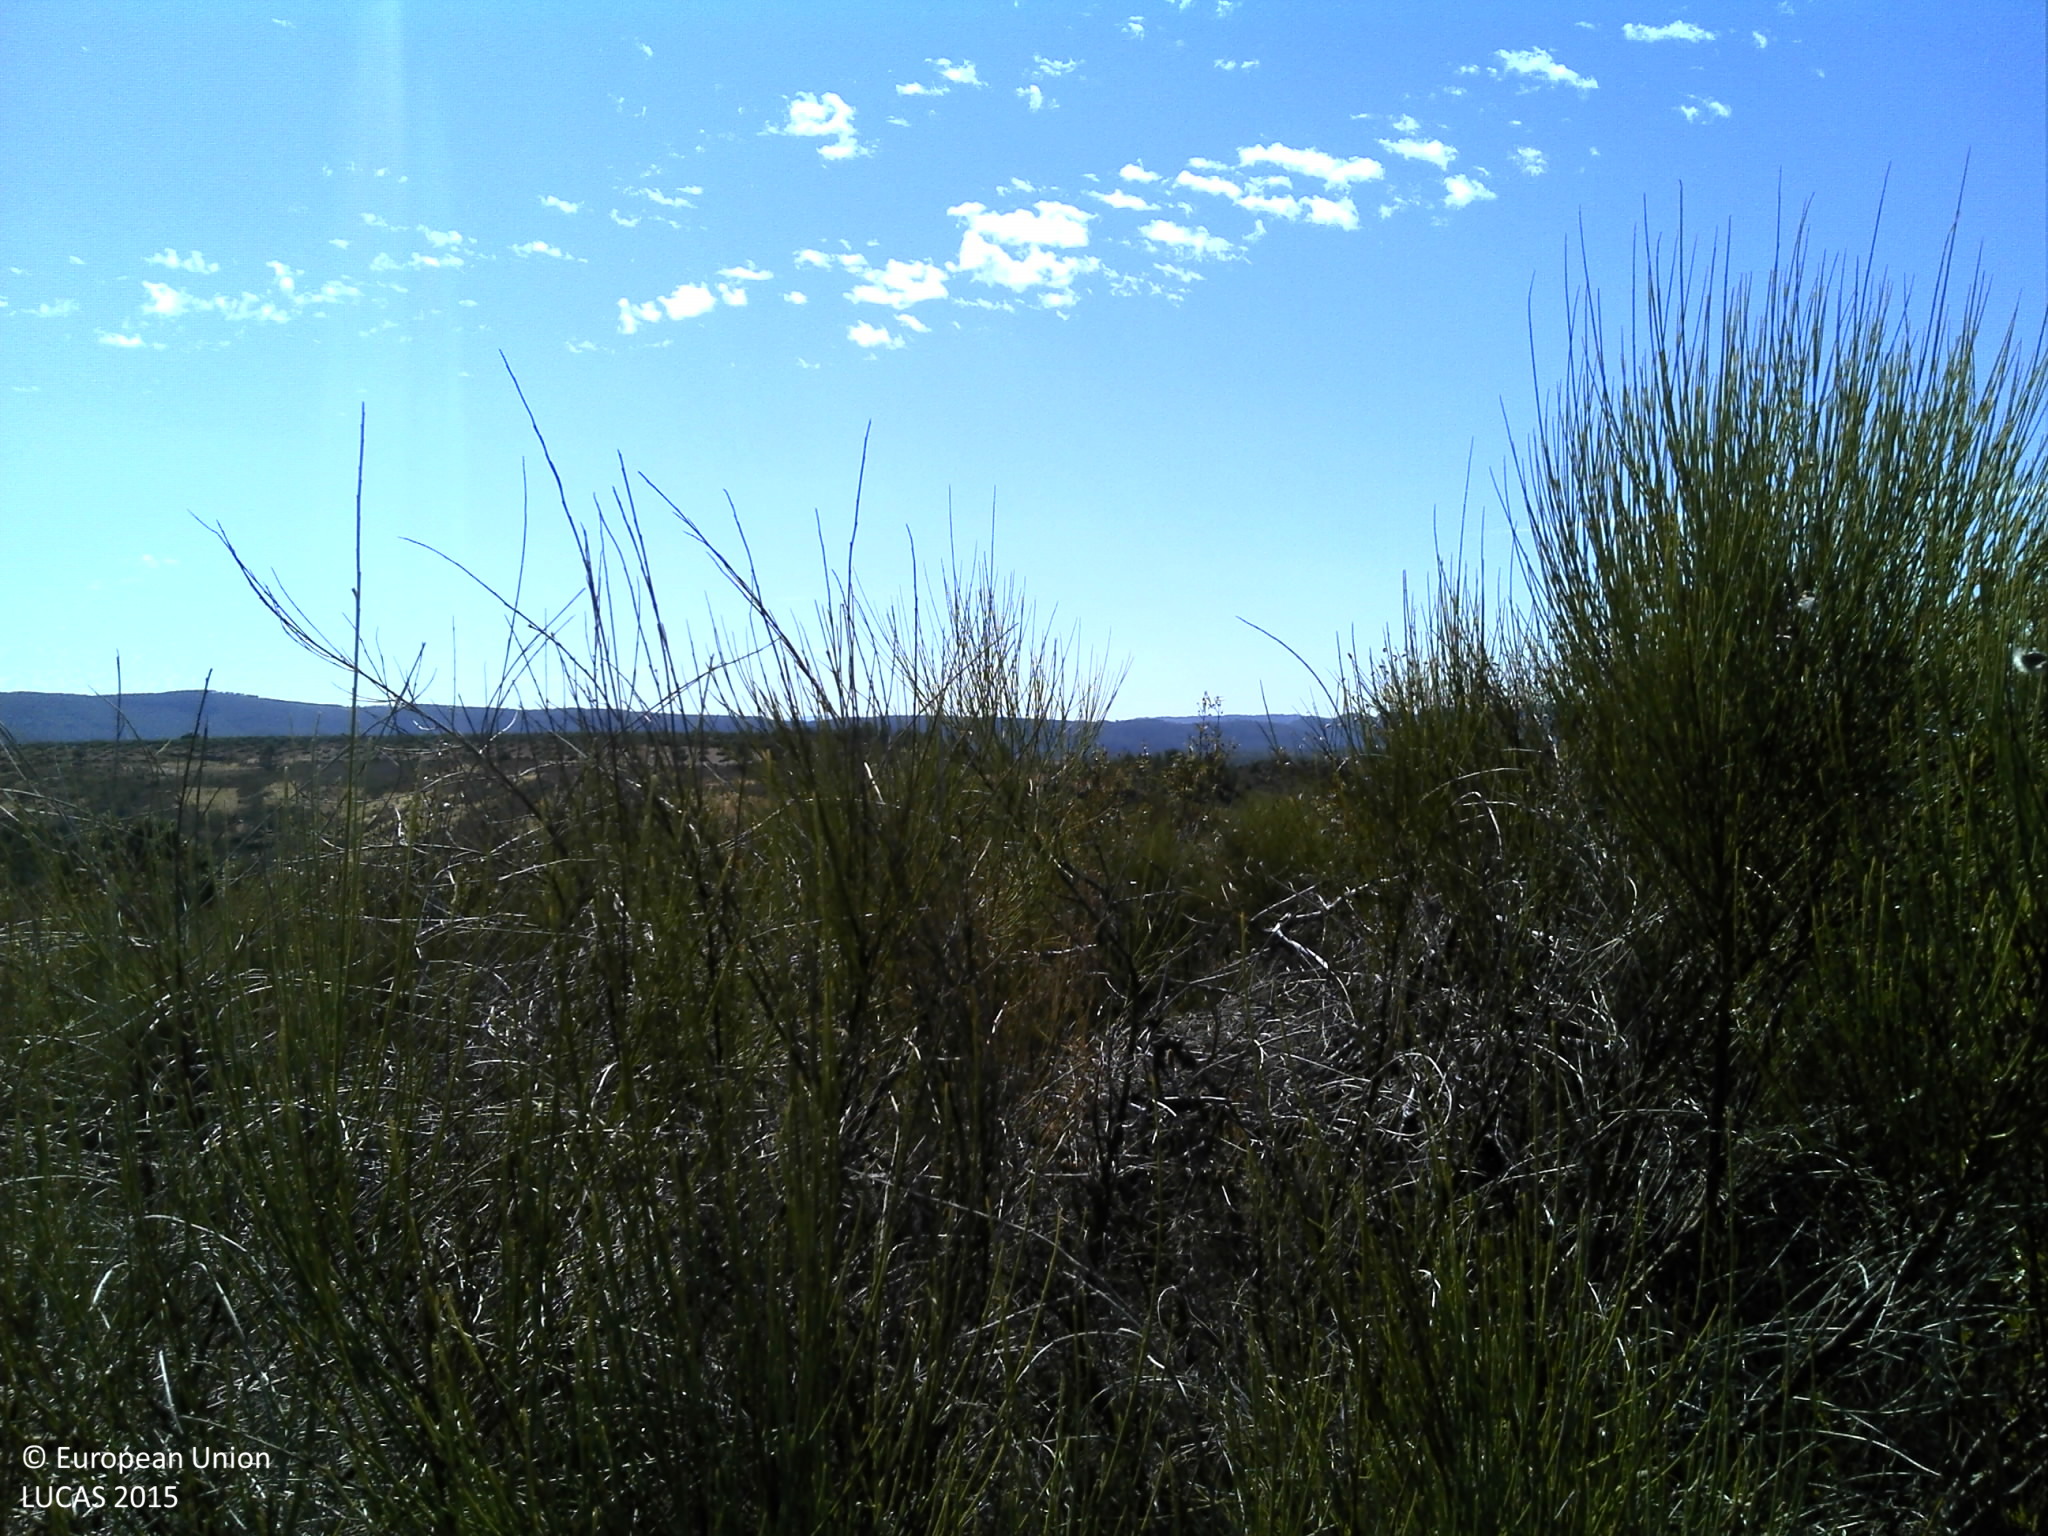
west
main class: Shrubland
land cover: Shrubland without tree cover
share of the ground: > 75 %
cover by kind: shrubs 100 %
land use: Semi-natural and natural areas not in use
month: August
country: PT
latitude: 39.6252
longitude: -7.5841
